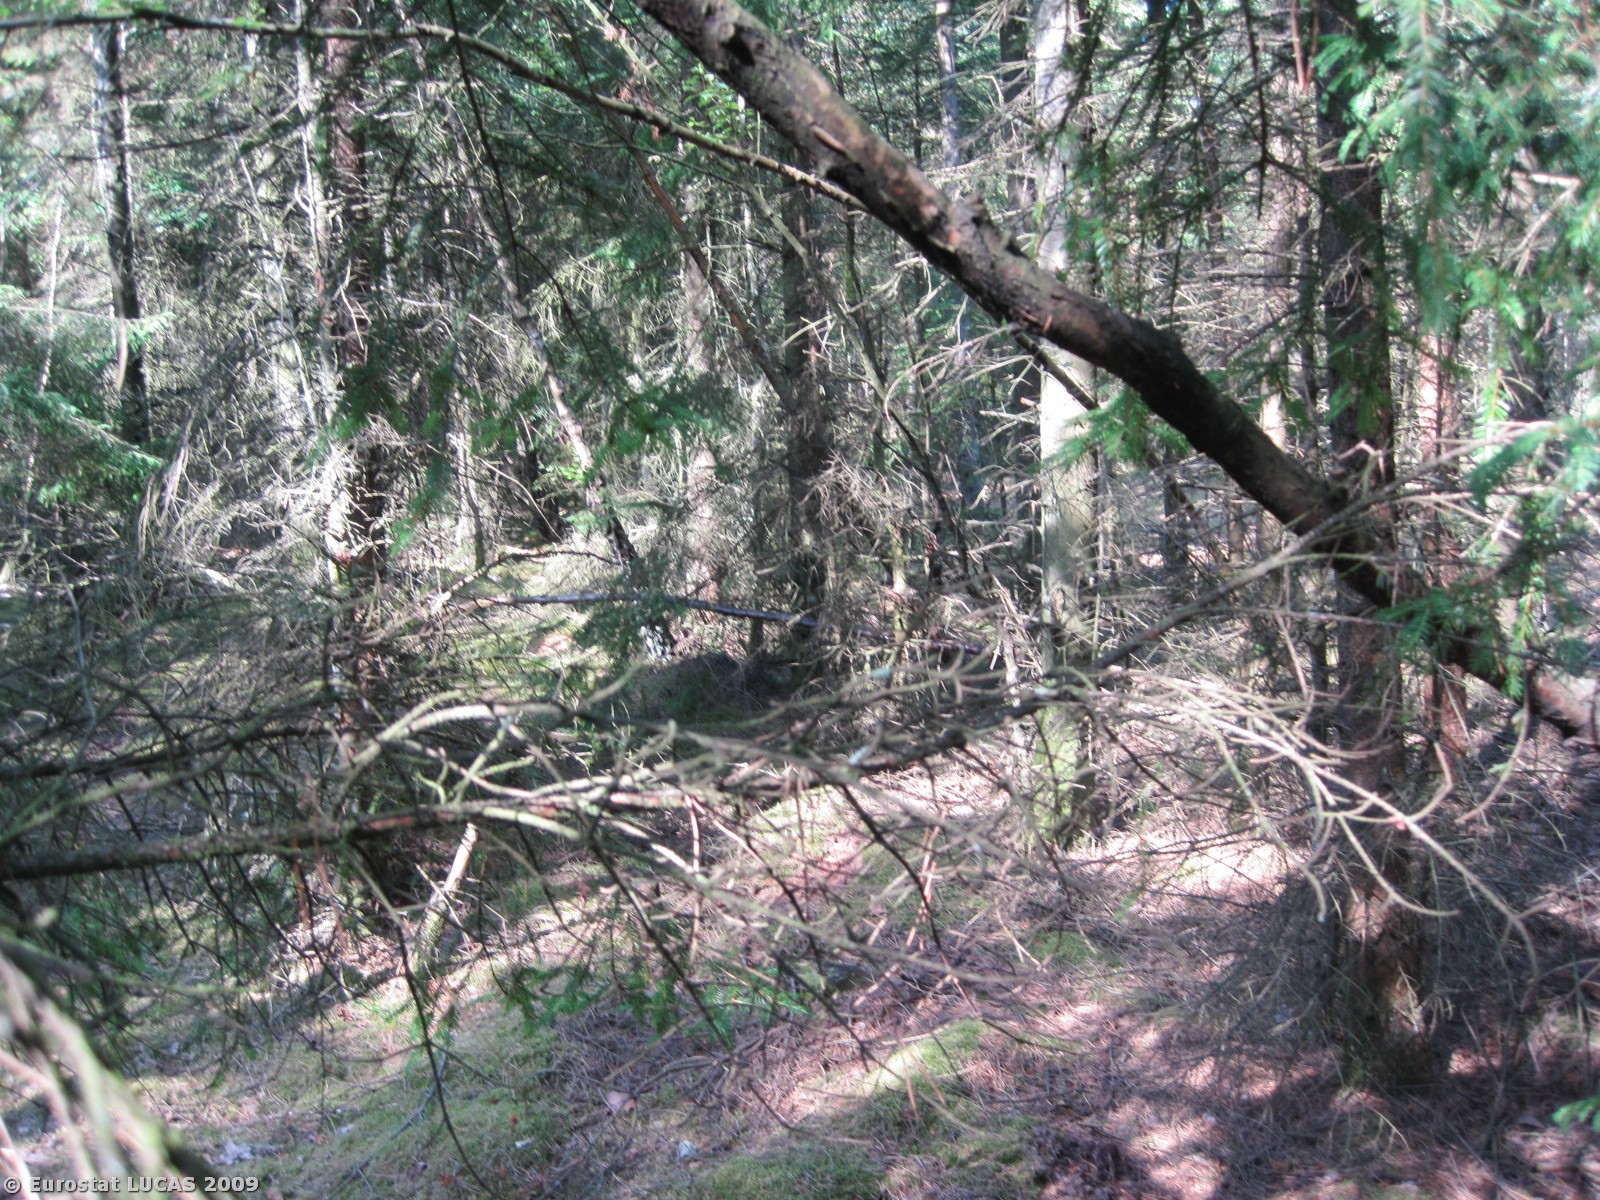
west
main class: Woodland
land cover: Coniferous woodland
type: plantations and self-sown exotic forest
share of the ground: > 75 %
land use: Forestry
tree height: > 5 m
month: July
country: DK
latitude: 56.5065
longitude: 8.8803
